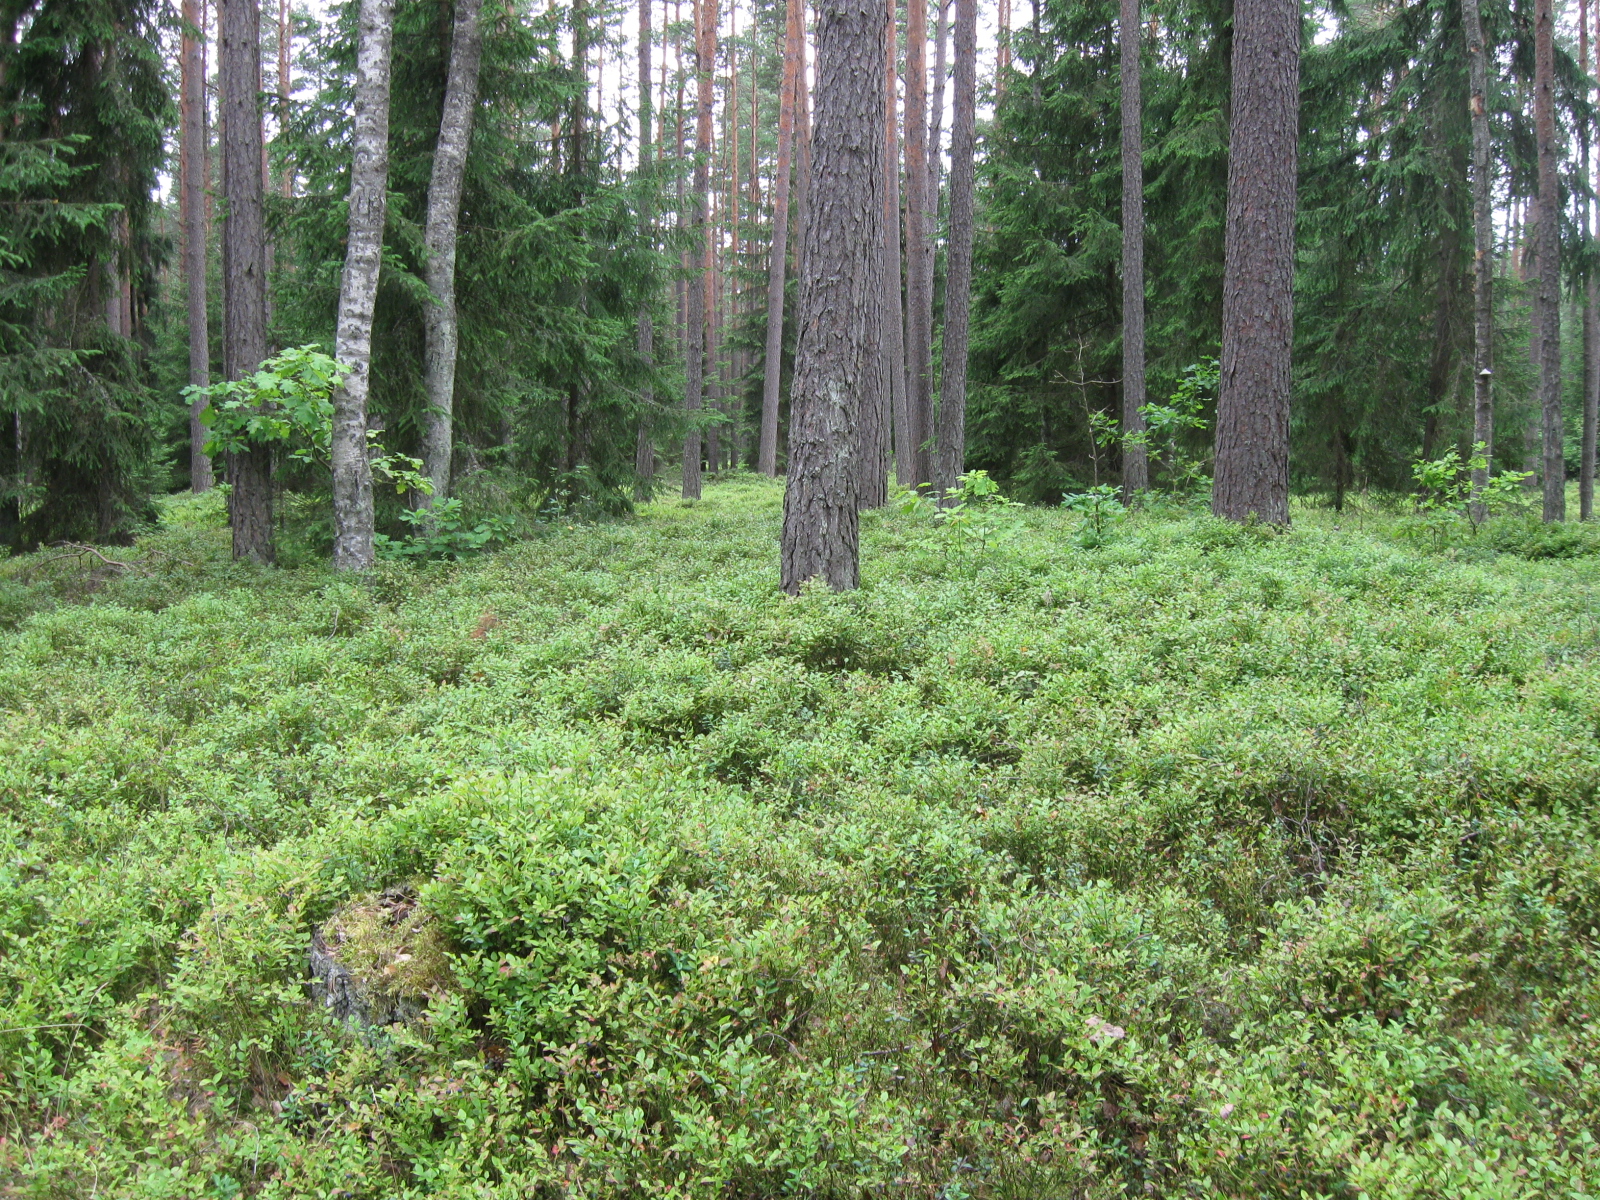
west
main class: Woodland
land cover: Pine dominated mixed woodland
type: hemiboreal forest and nemoral coniferous forest and mixed broadleaved-coniferous forest
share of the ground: > 75 %
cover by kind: coniferous forest trees 50 %, broadleaved forest trees 30 %, shrubs 10 %, herbaceous plants 5 %, lichens and mosses 5 %
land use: Forestry
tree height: > 5 m
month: July
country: LT
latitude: 54.8544
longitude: 23.6194
